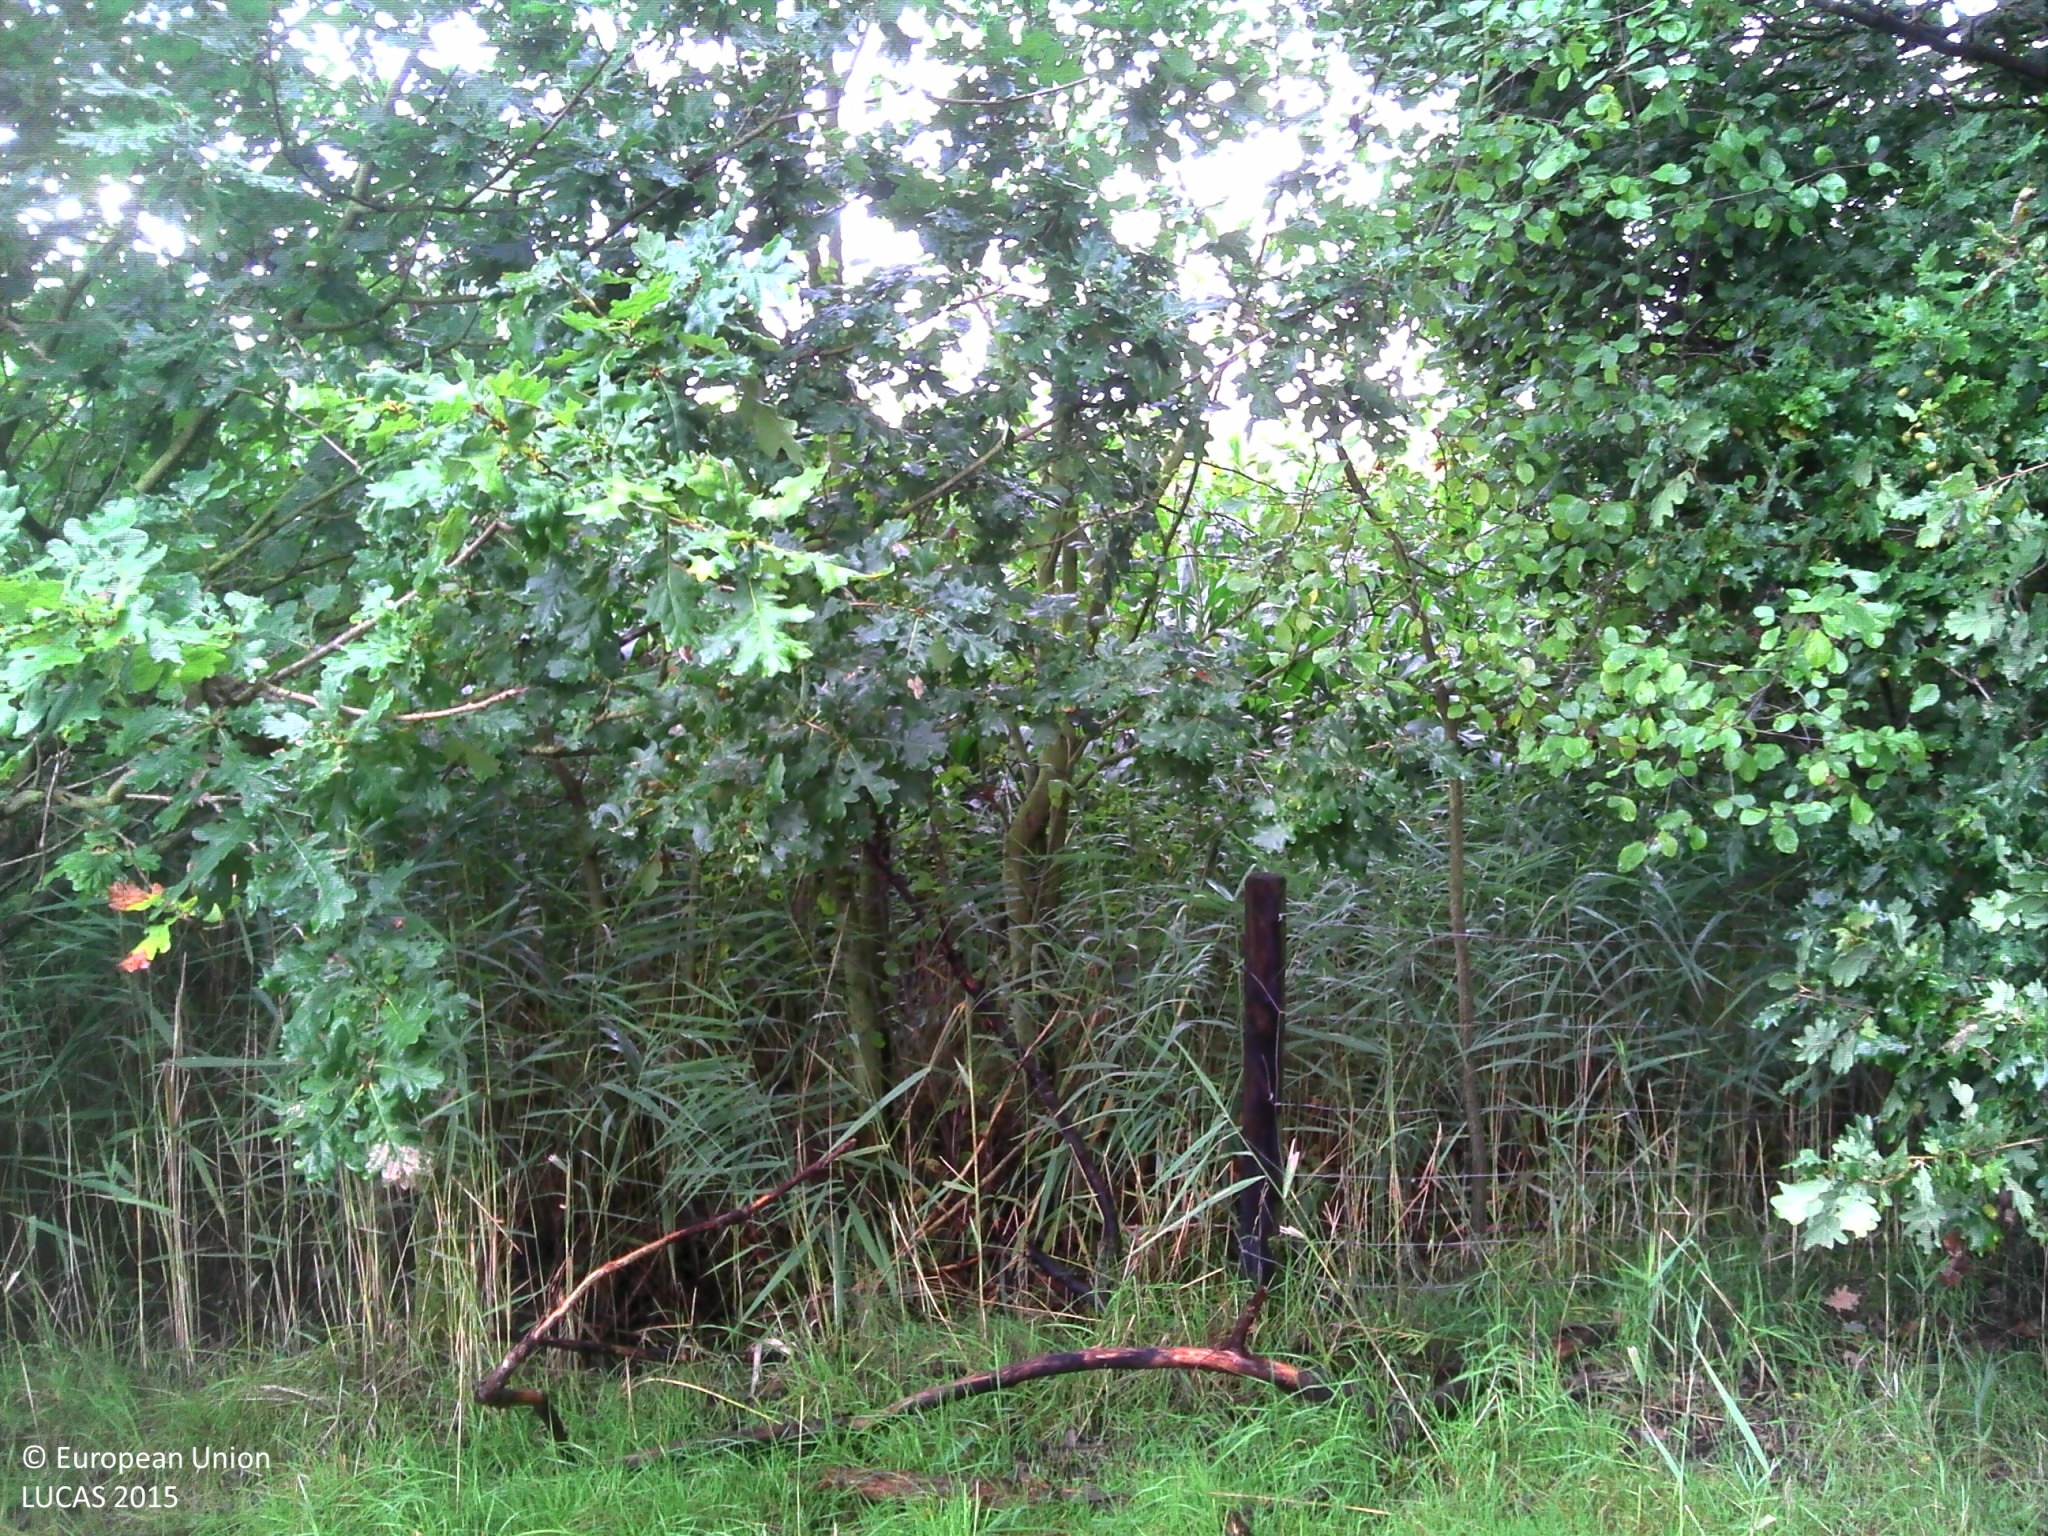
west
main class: Grassland
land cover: Grassland without tree/shrub cover
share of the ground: > 75 %
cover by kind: herbaceous plants 100 %
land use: Agriculture (excluding fallow land and kitchen gardens)
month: September
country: BE
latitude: 51.2481
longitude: 4.6524
